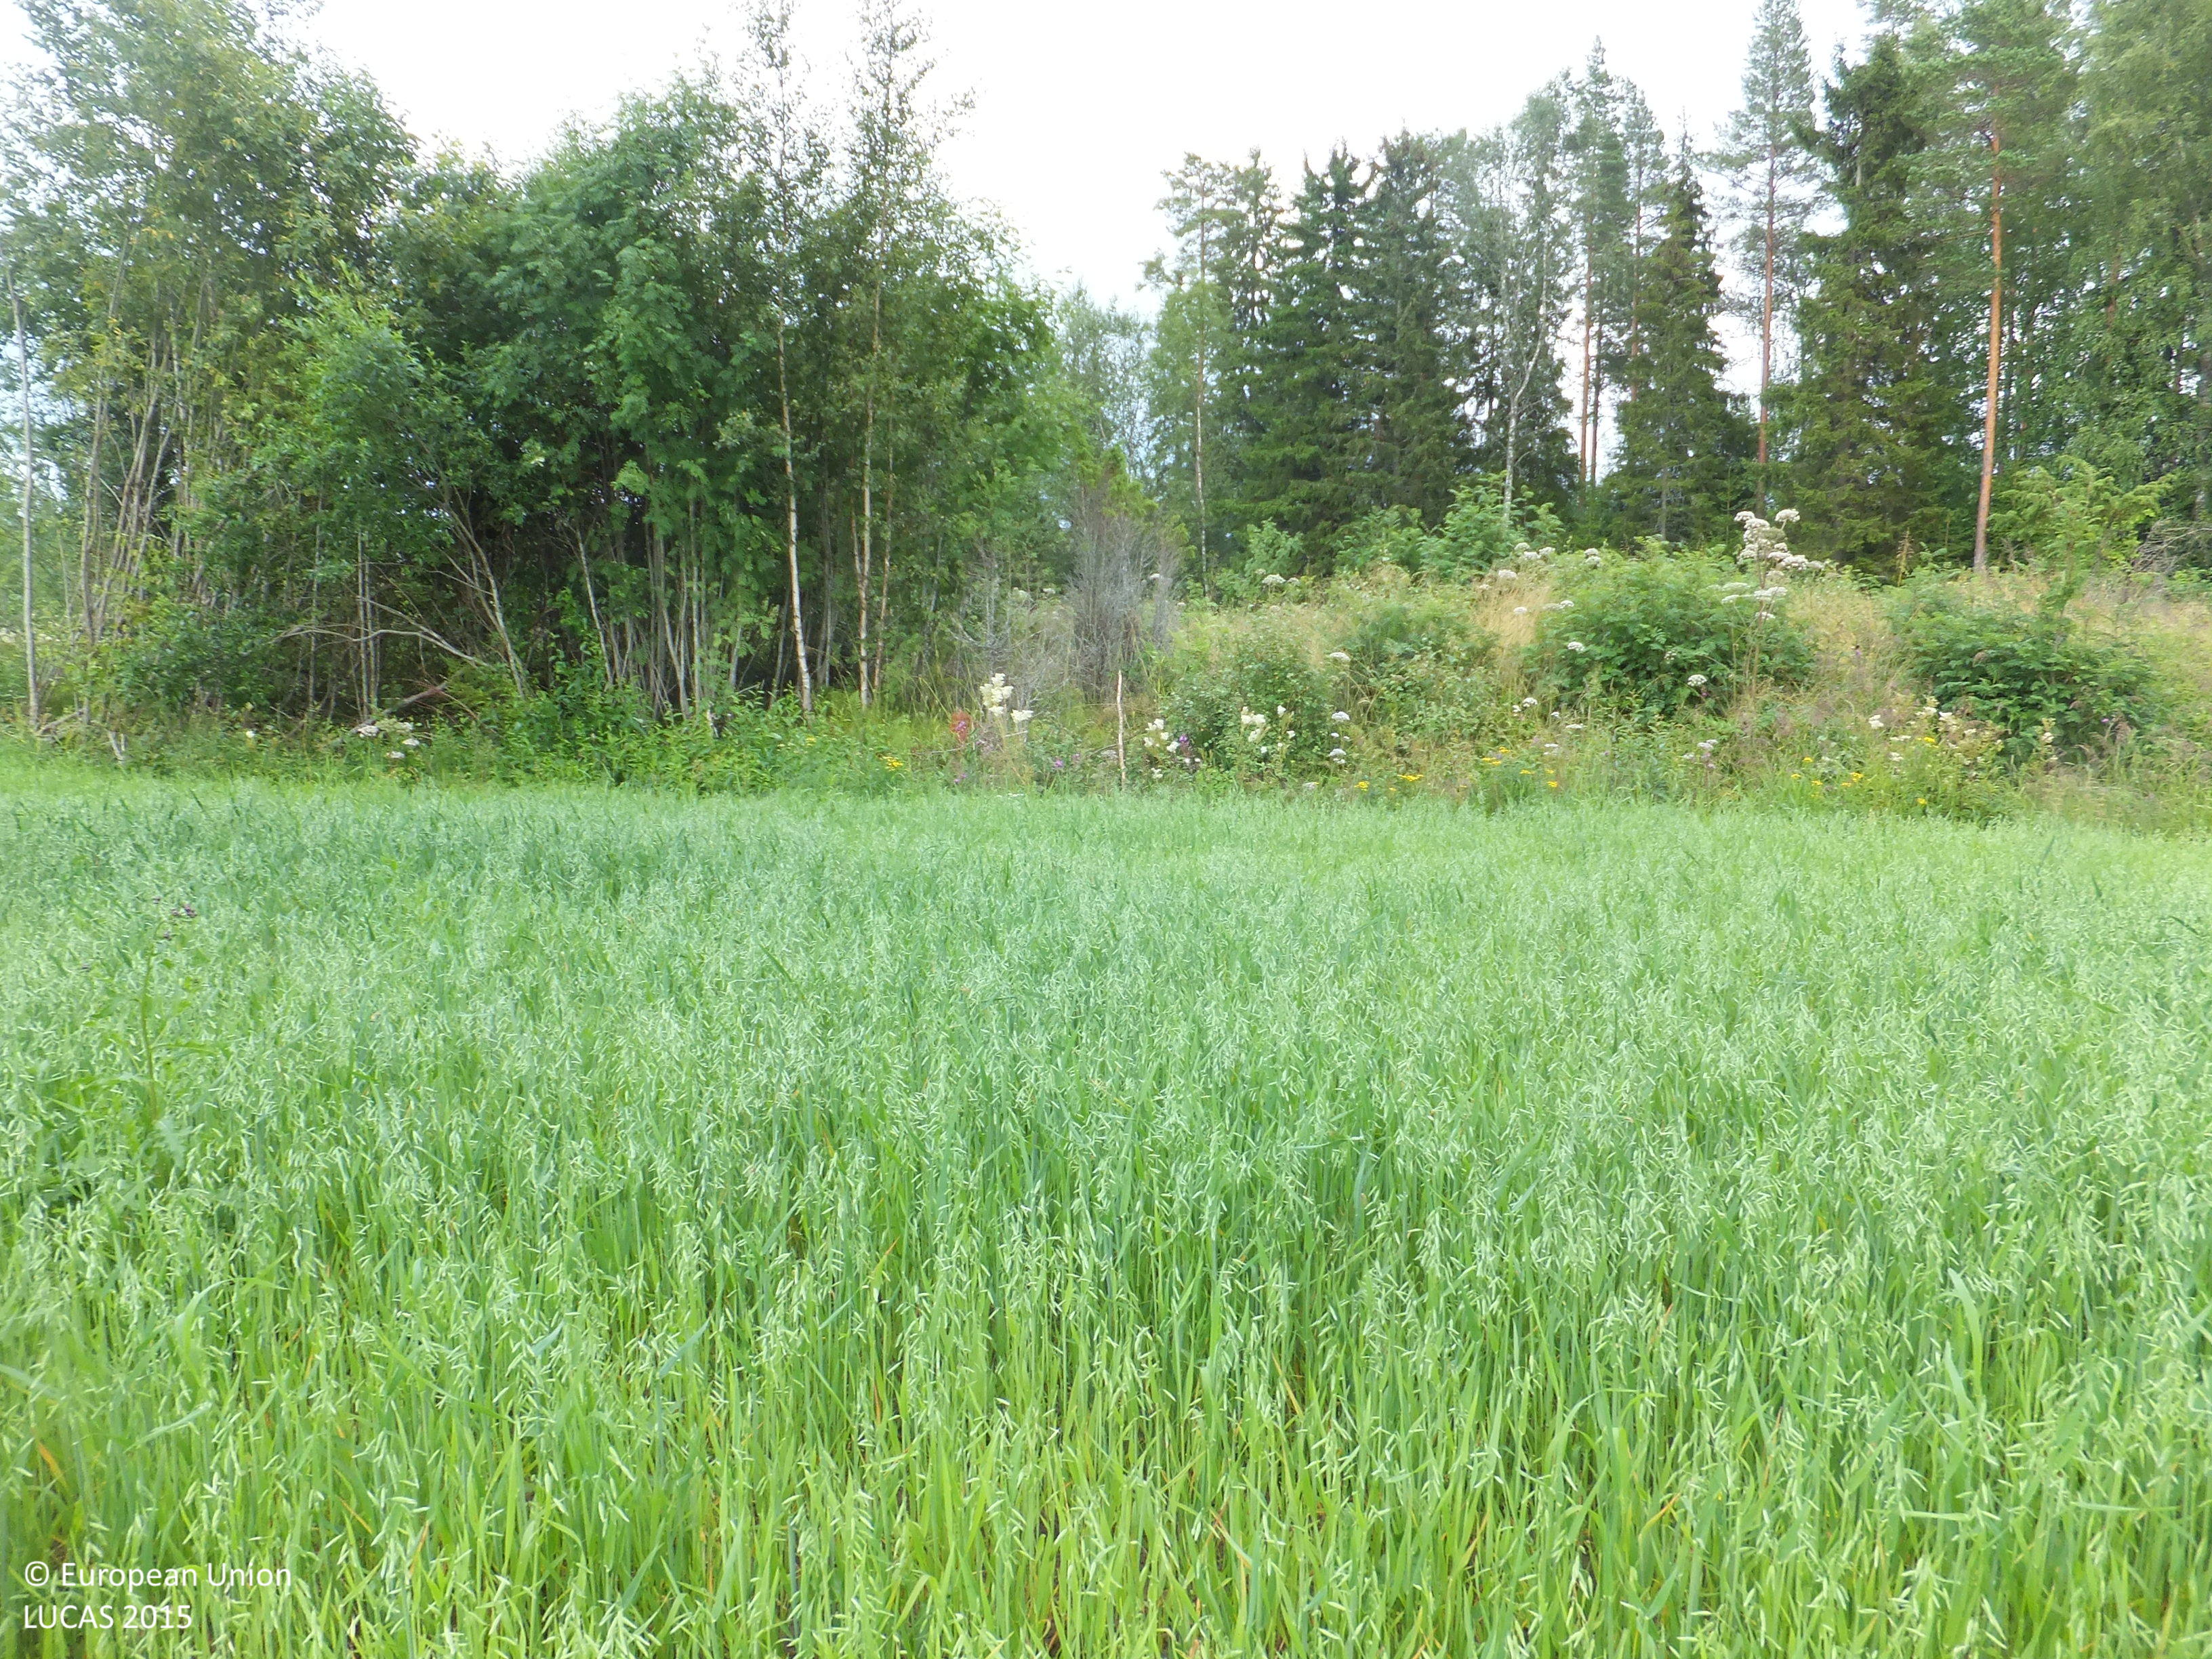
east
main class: Artificial land
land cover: Other artificial areas
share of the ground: > 75 %
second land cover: Oats
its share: > 75 %
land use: Electricity, gas and thermal power distribution
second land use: Agriculture (excluding fallow land and kitchen gardens)
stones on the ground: < 10 %
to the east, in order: Artificial constructions in urban areas; Oats; Grass margins; Ditches and canals; Broadleaved woodland; Electric lines; Tracks; Other mixed woodland; Electric lines; Ditches and canals; Grass margins; Paved roads, cycling and walking lanes; Ditches and canals; Spruce dominated mixed woodland; Grassland without tree/shrub cover; Spruce dominated mixed woodland; Shruby margins; Grassland without tree/shrub cover
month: July
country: FI
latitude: 63.0709
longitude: 21.8986
